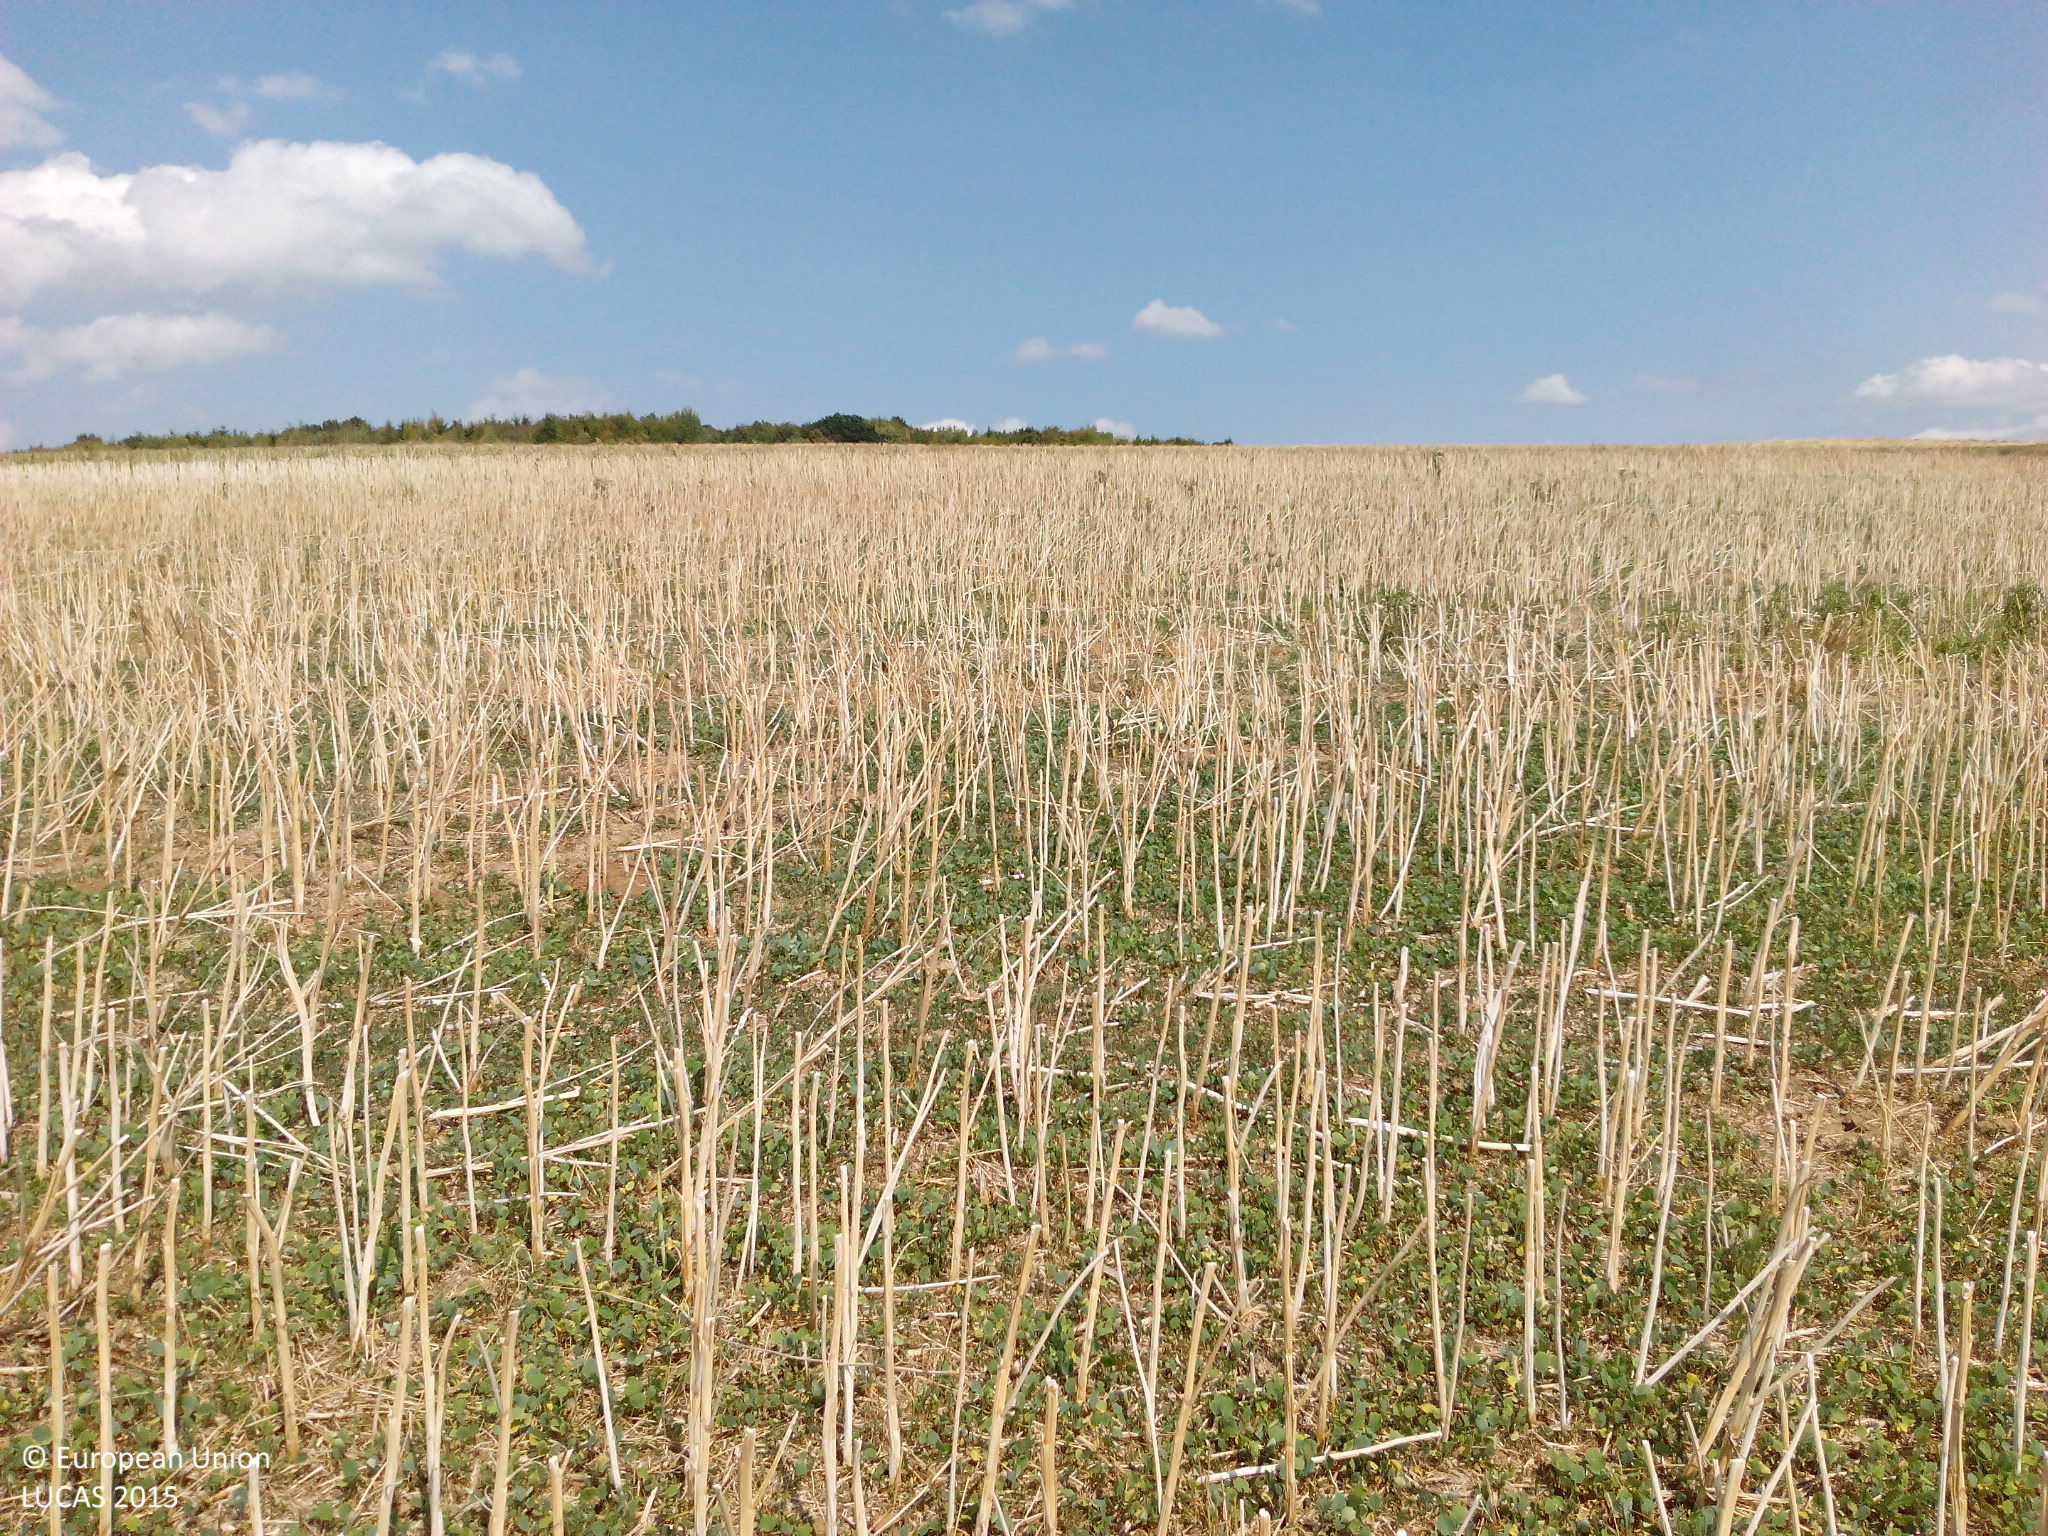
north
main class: Cropland
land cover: Rape and turnip rape
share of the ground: < 10 %
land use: Agriculture (excluding fallow land and kitchen gardens)
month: August
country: DE
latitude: 50.3488
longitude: 8.1313
